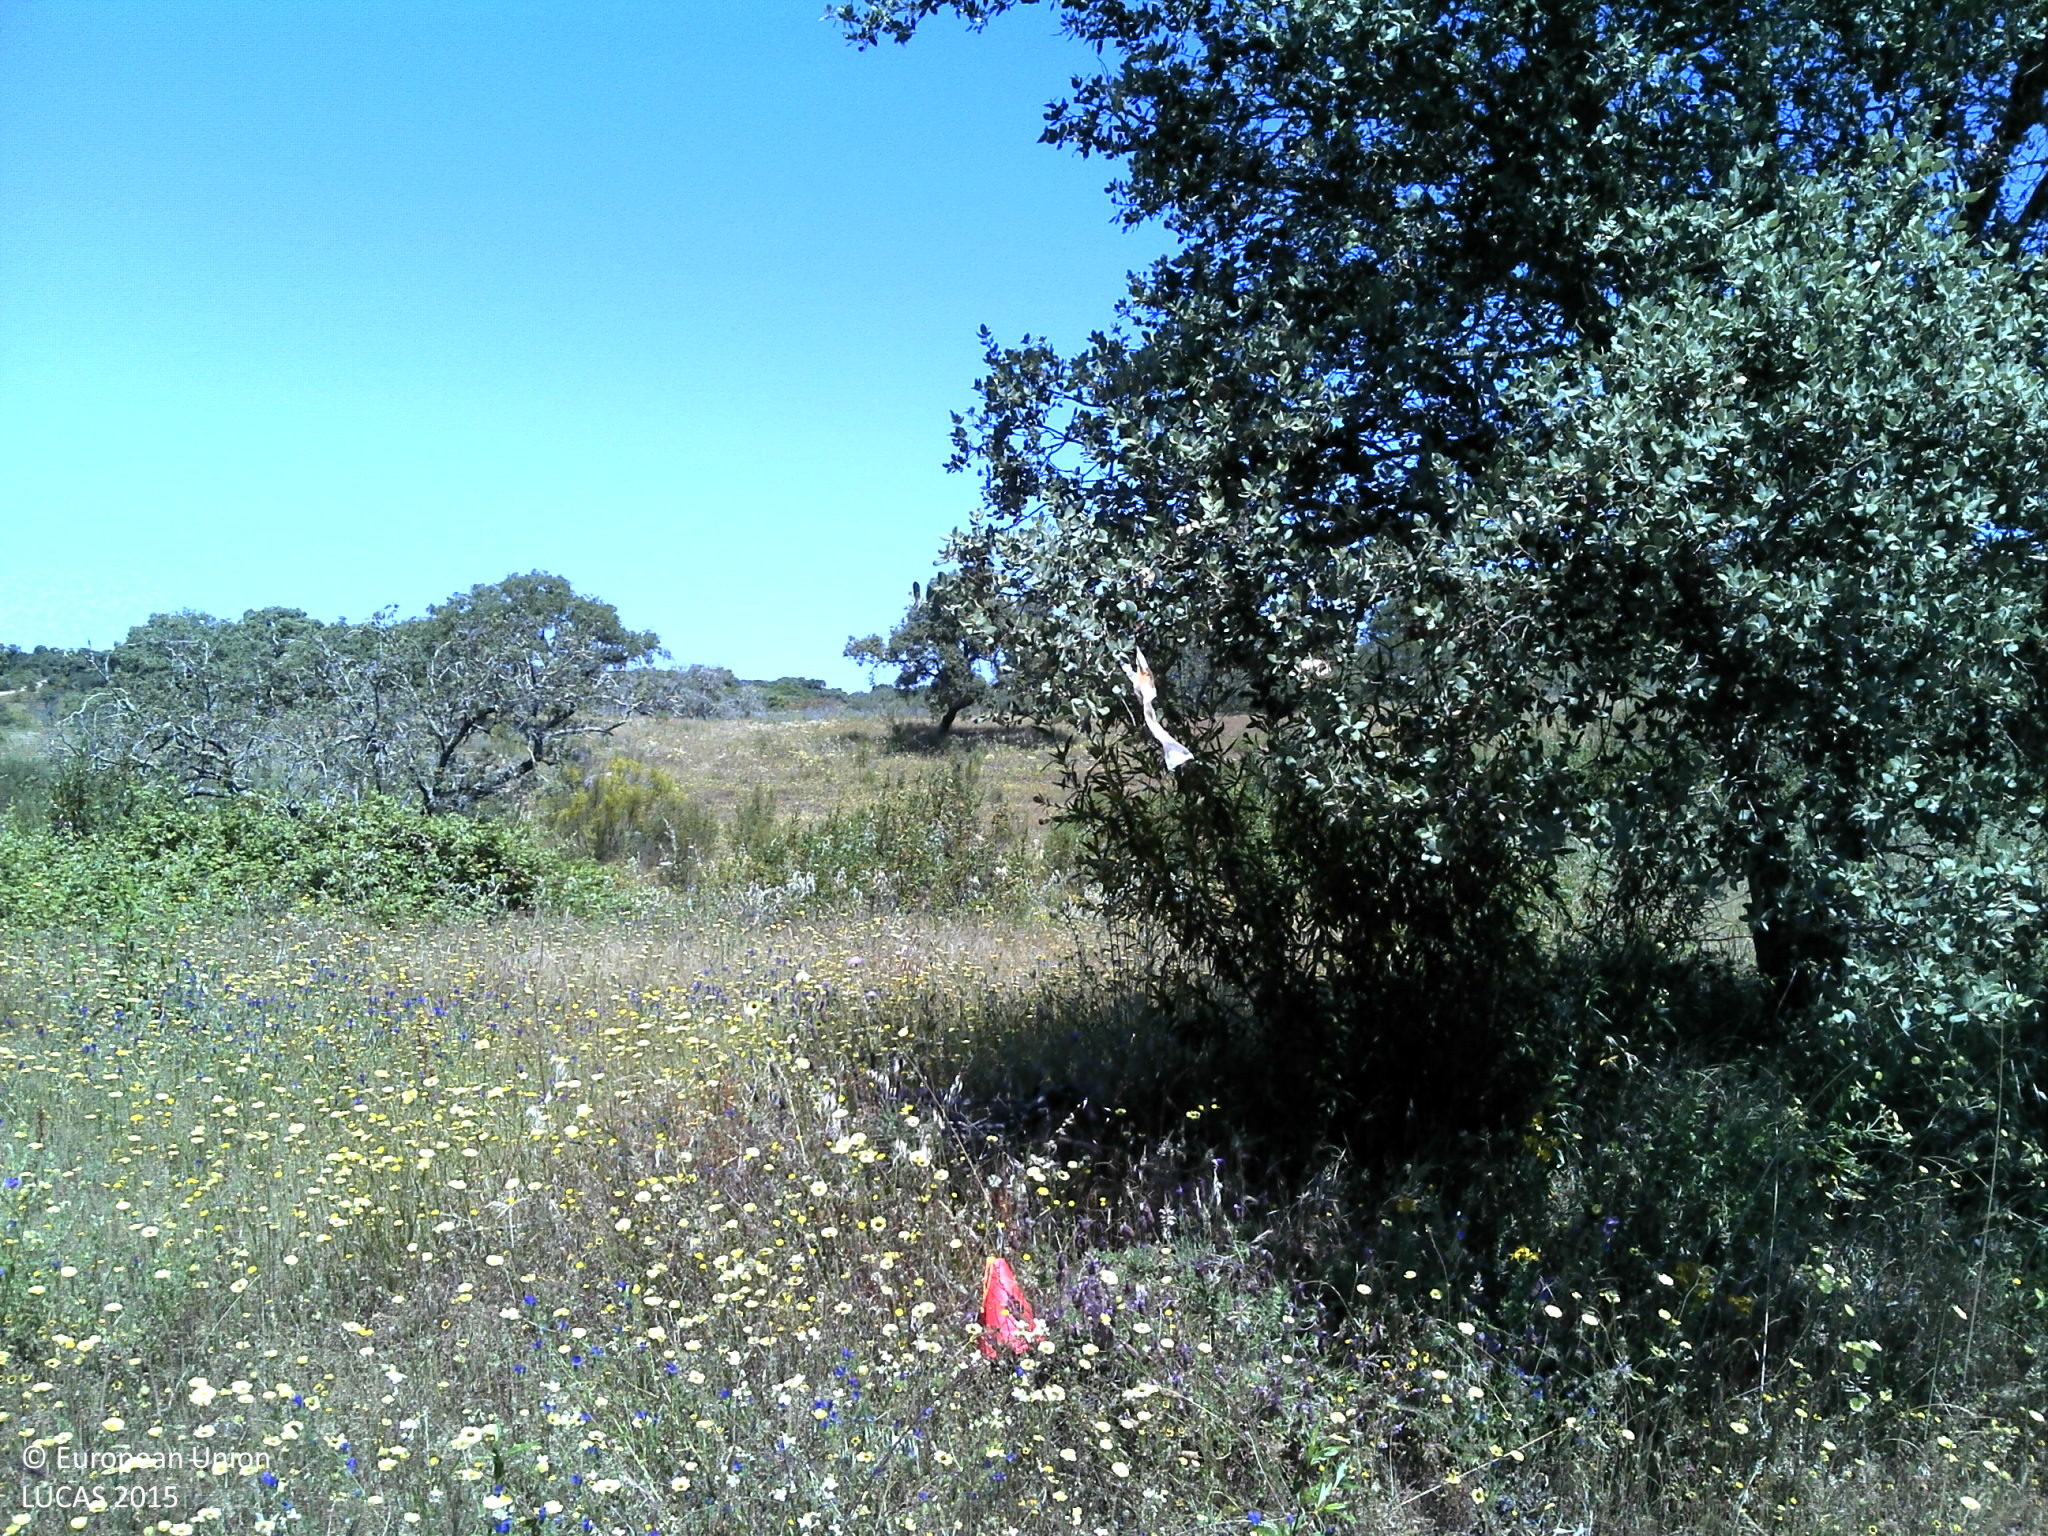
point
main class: Woodland
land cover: Broadleaved woodland
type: broadleaved evergreen forest
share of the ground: 10 - 25 %
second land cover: Grassland without tree/shrub cover
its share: 25 - 50 %
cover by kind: broadleaved forest trees 25 %, shrubs 25 %, herbaceous plants 25 %, unconsolidated bare surface 25 %
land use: Forestry
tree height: > 5 m
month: May
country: PT
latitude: 39.2068
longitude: -7.8492
